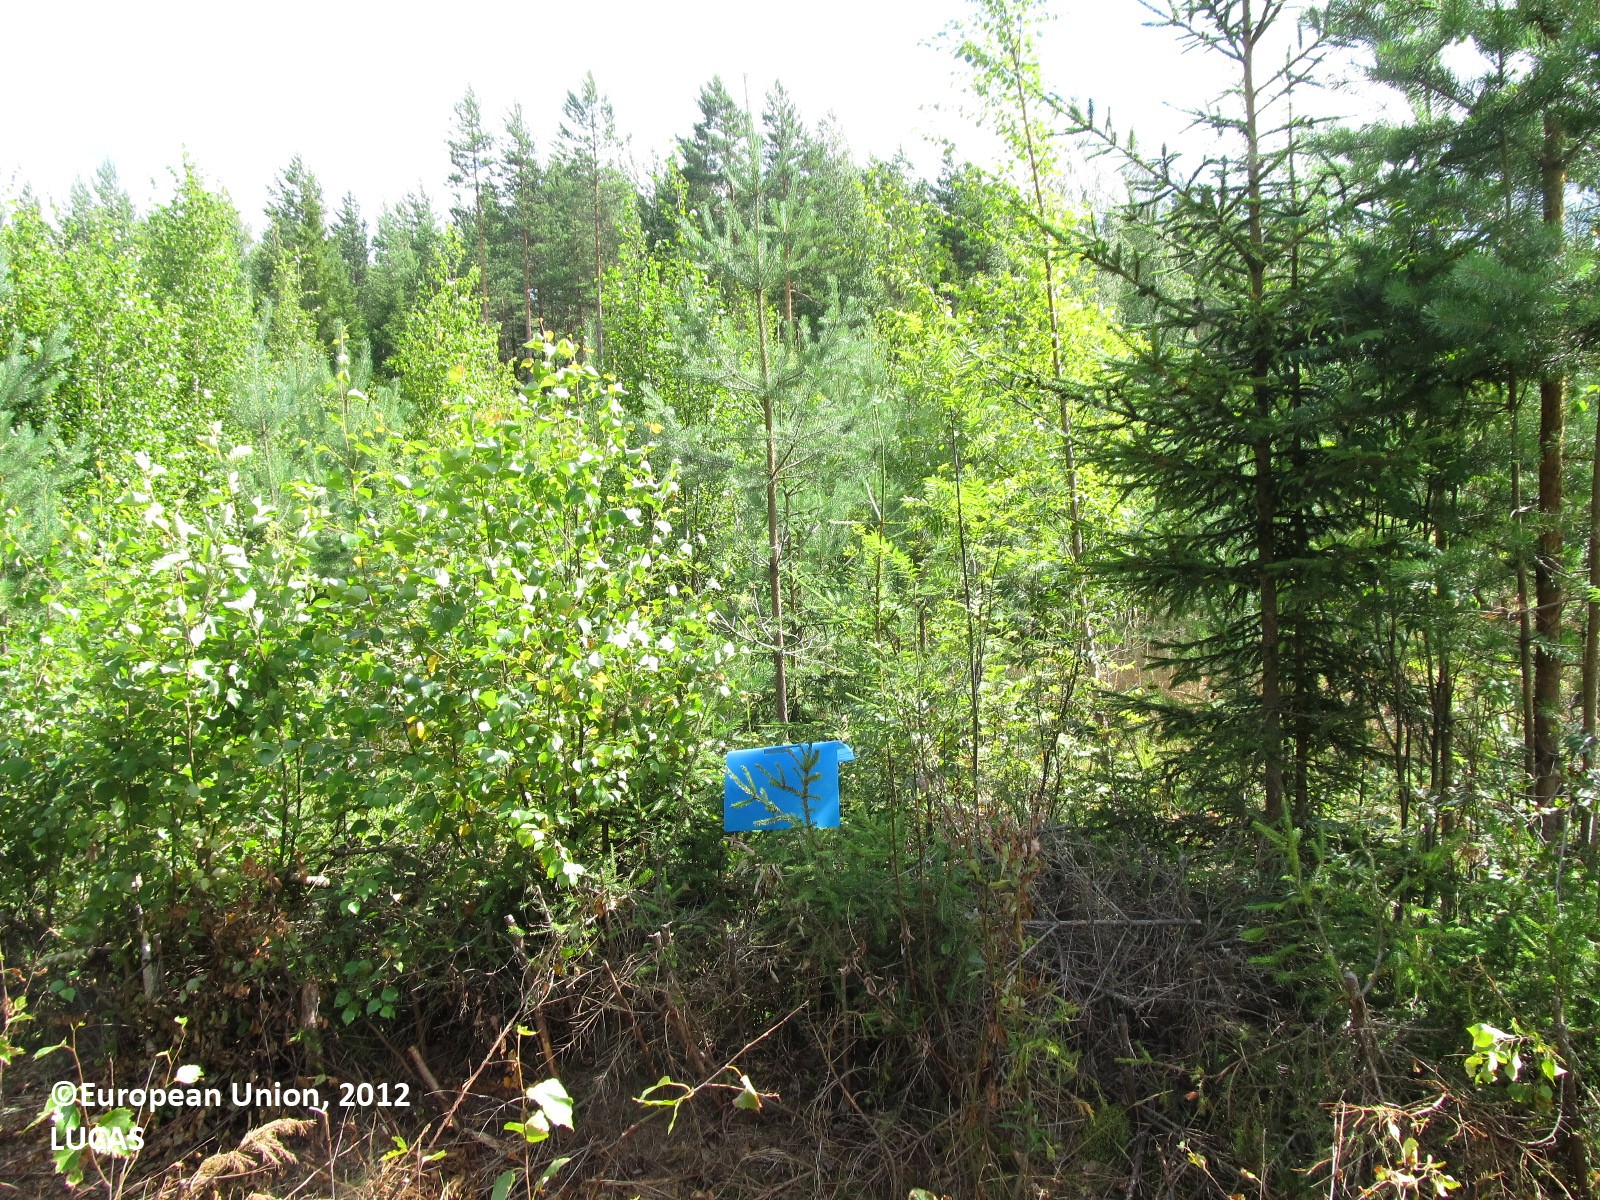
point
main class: Woodland
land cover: Pine dominated mixed woodland
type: boreal forest
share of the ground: 50 - 75 %
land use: Forestry
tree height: < 5 m
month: August
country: FI
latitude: 61.6874
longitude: 27.9378
